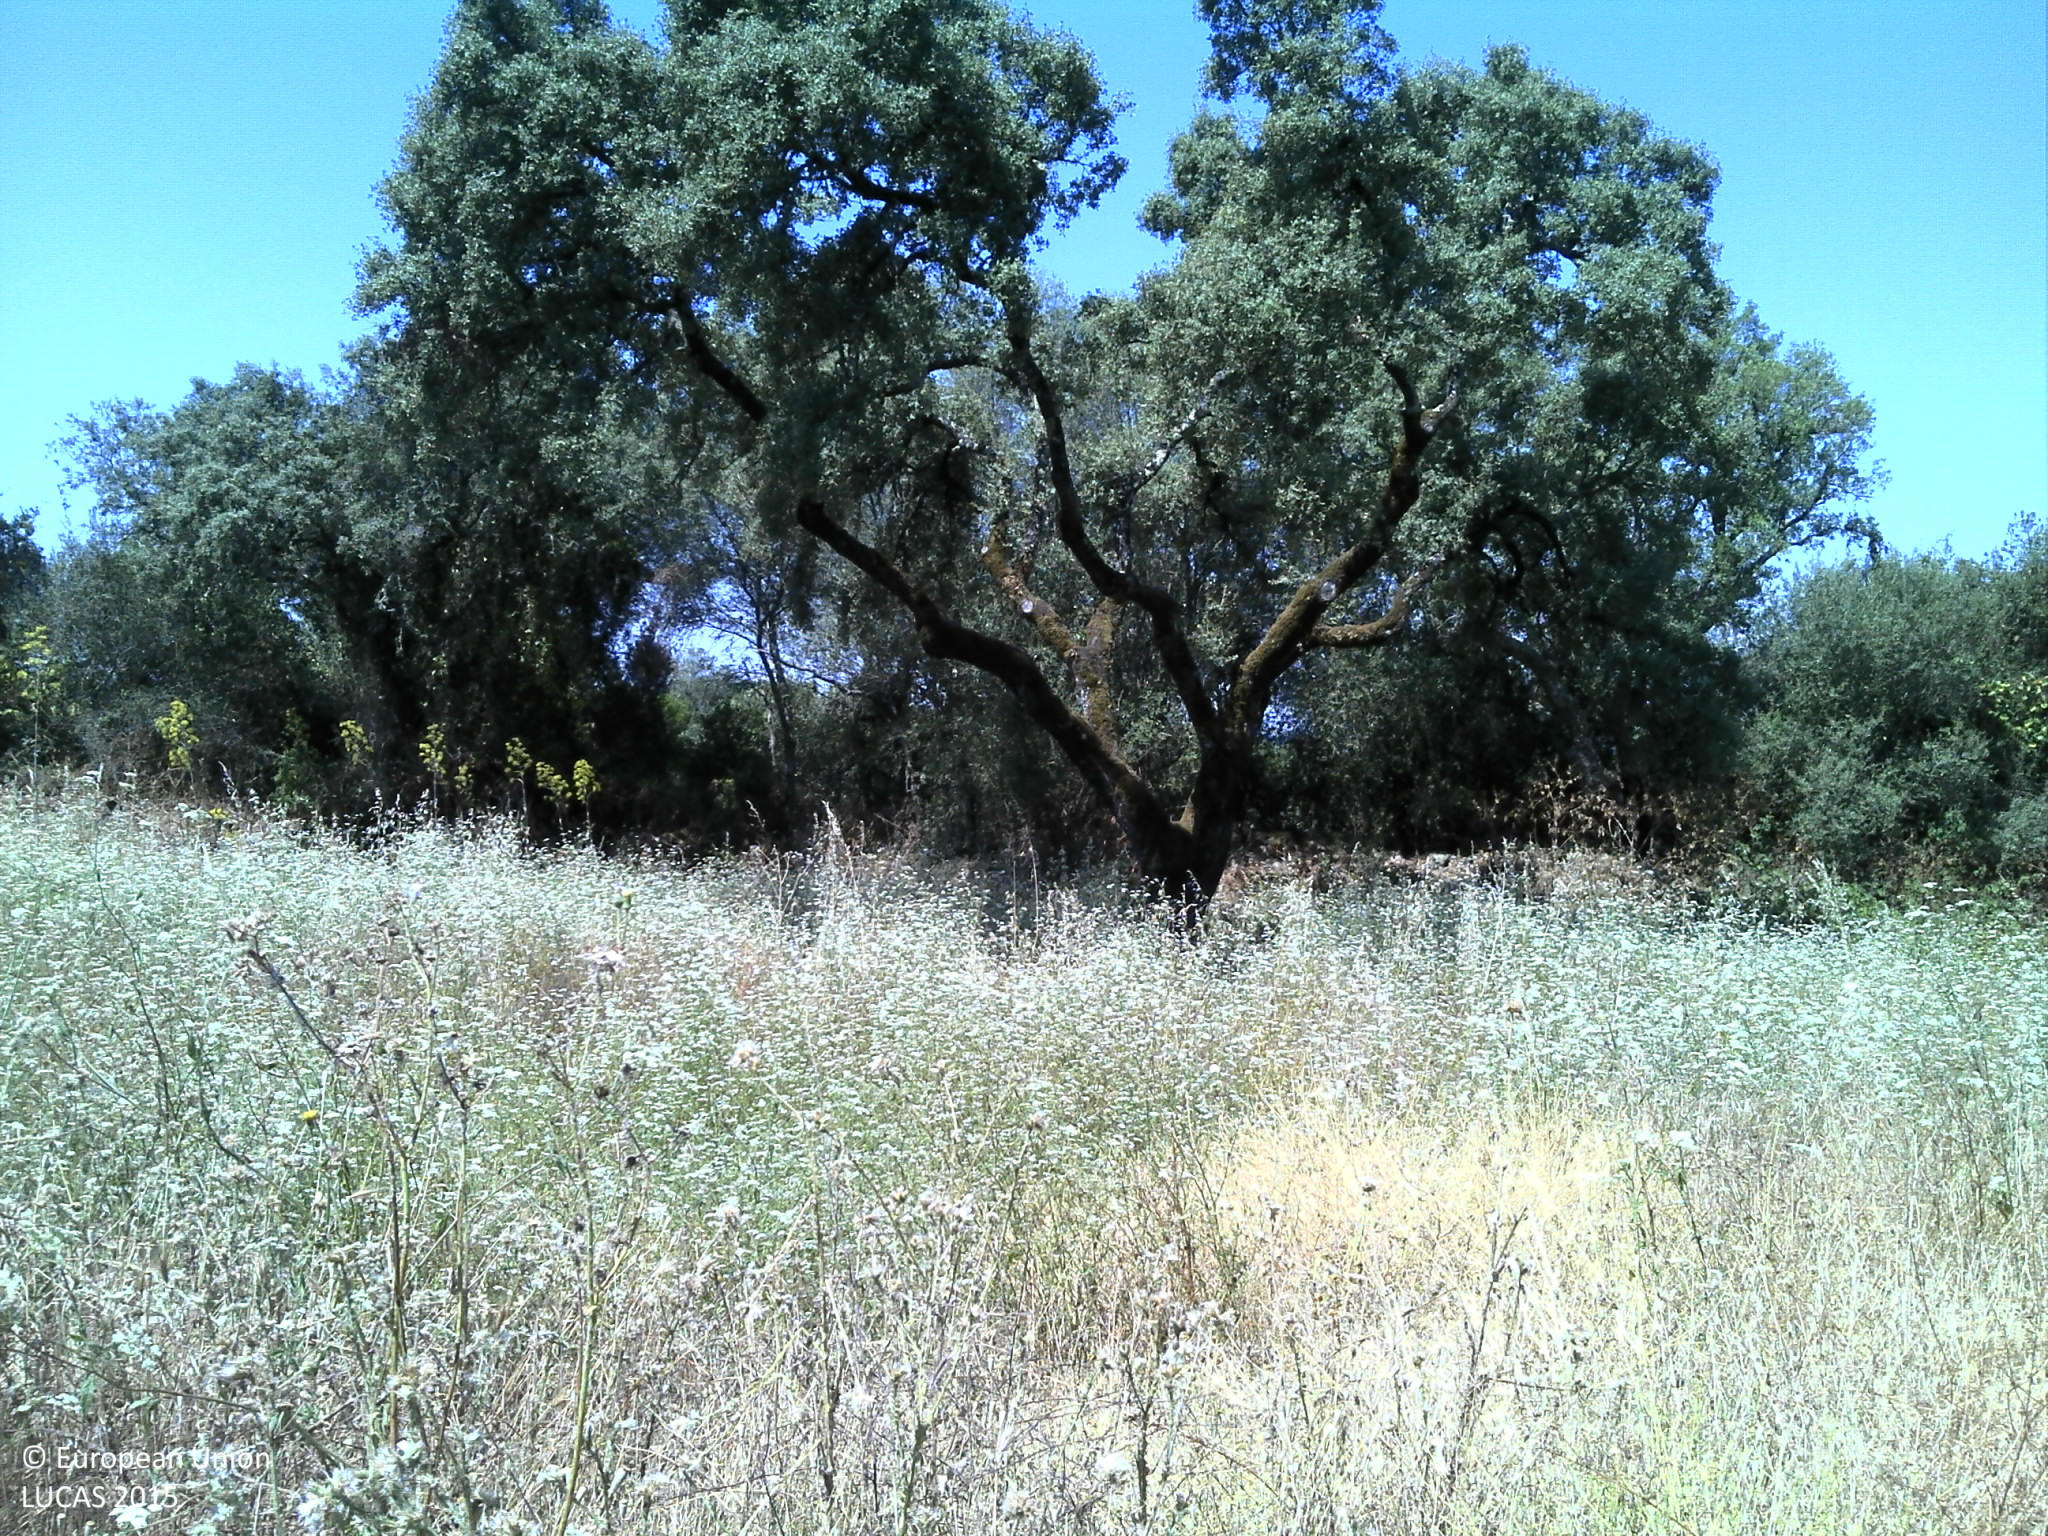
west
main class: Woodland
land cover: Broadleaved woodland
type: broadleaved evergreen forest
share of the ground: > 75 %
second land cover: Grassland without tree/shrub cover
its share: > 75 %
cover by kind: broadleaved forest trees 75 %, herbaceous plants 25 %
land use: Forestry
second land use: Agriculture (excluding fallow land and kitchen gardens)
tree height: > 5 m
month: June
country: PT
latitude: 38.6210
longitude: -8.1124
